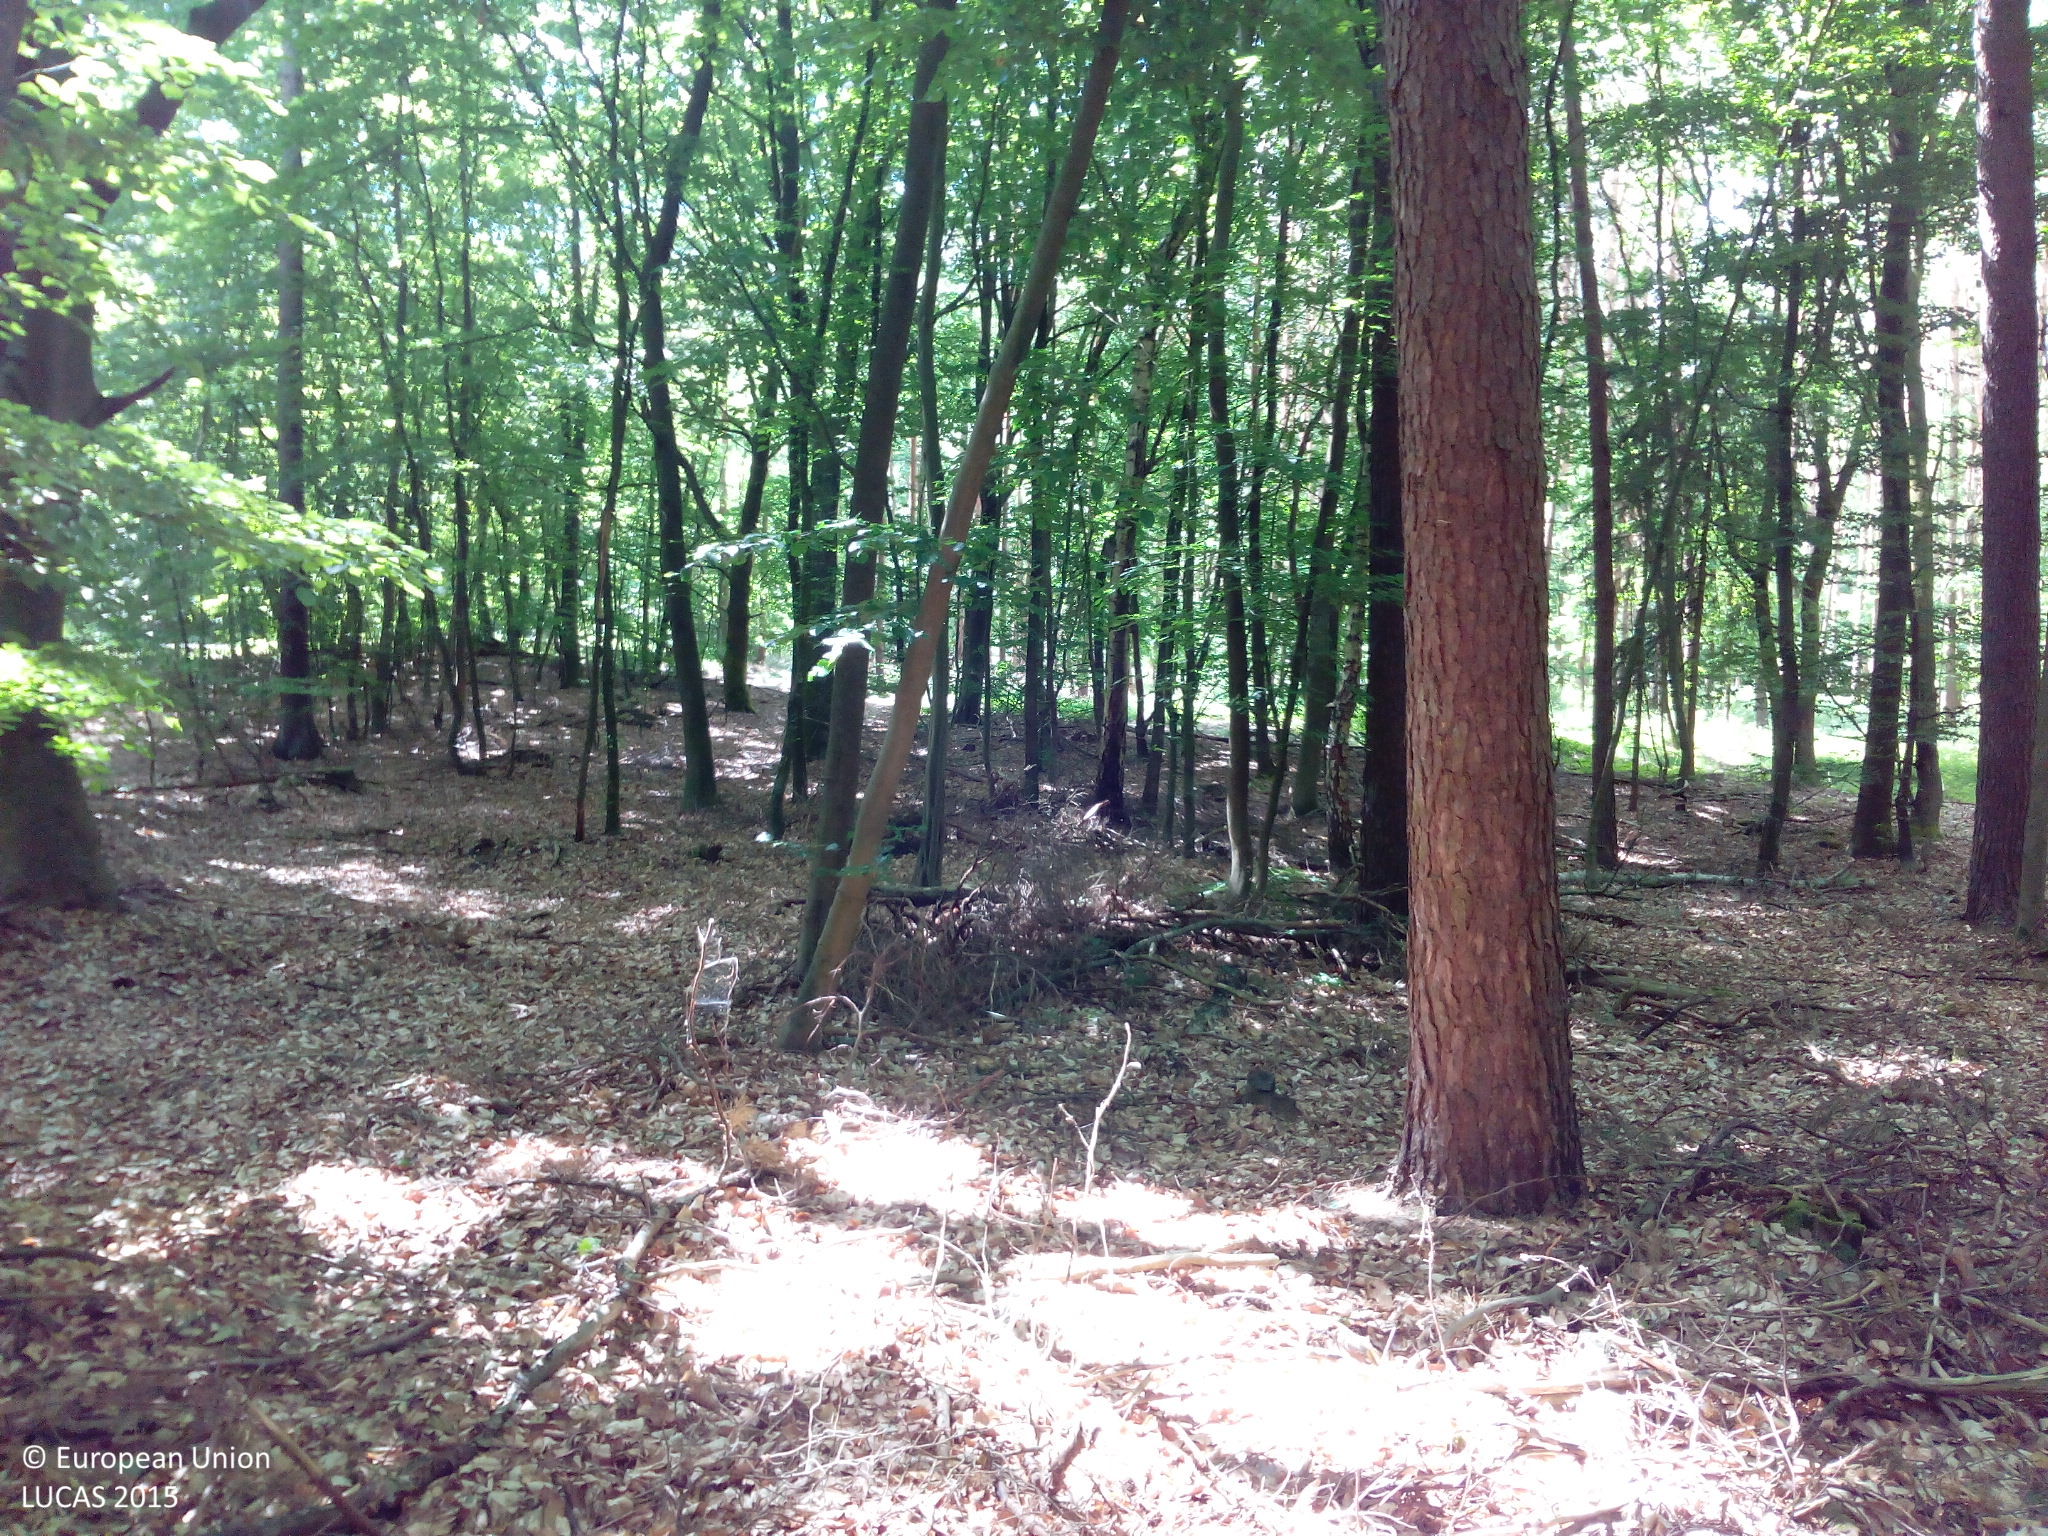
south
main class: Woodland
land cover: Pine dominated mixed woodland
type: hemiboreal forest and nemoral coniferous forest and mixed broadleaved-coniferous forest
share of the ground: > 75 %
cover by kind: coniferous forest trees 50 %, broadleaved forest trees 40 %, unconsolidated bare surface 10 %
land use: Forestry
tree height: > 5 m
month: June
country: DE
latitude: 53.5526
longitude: 11.6446
